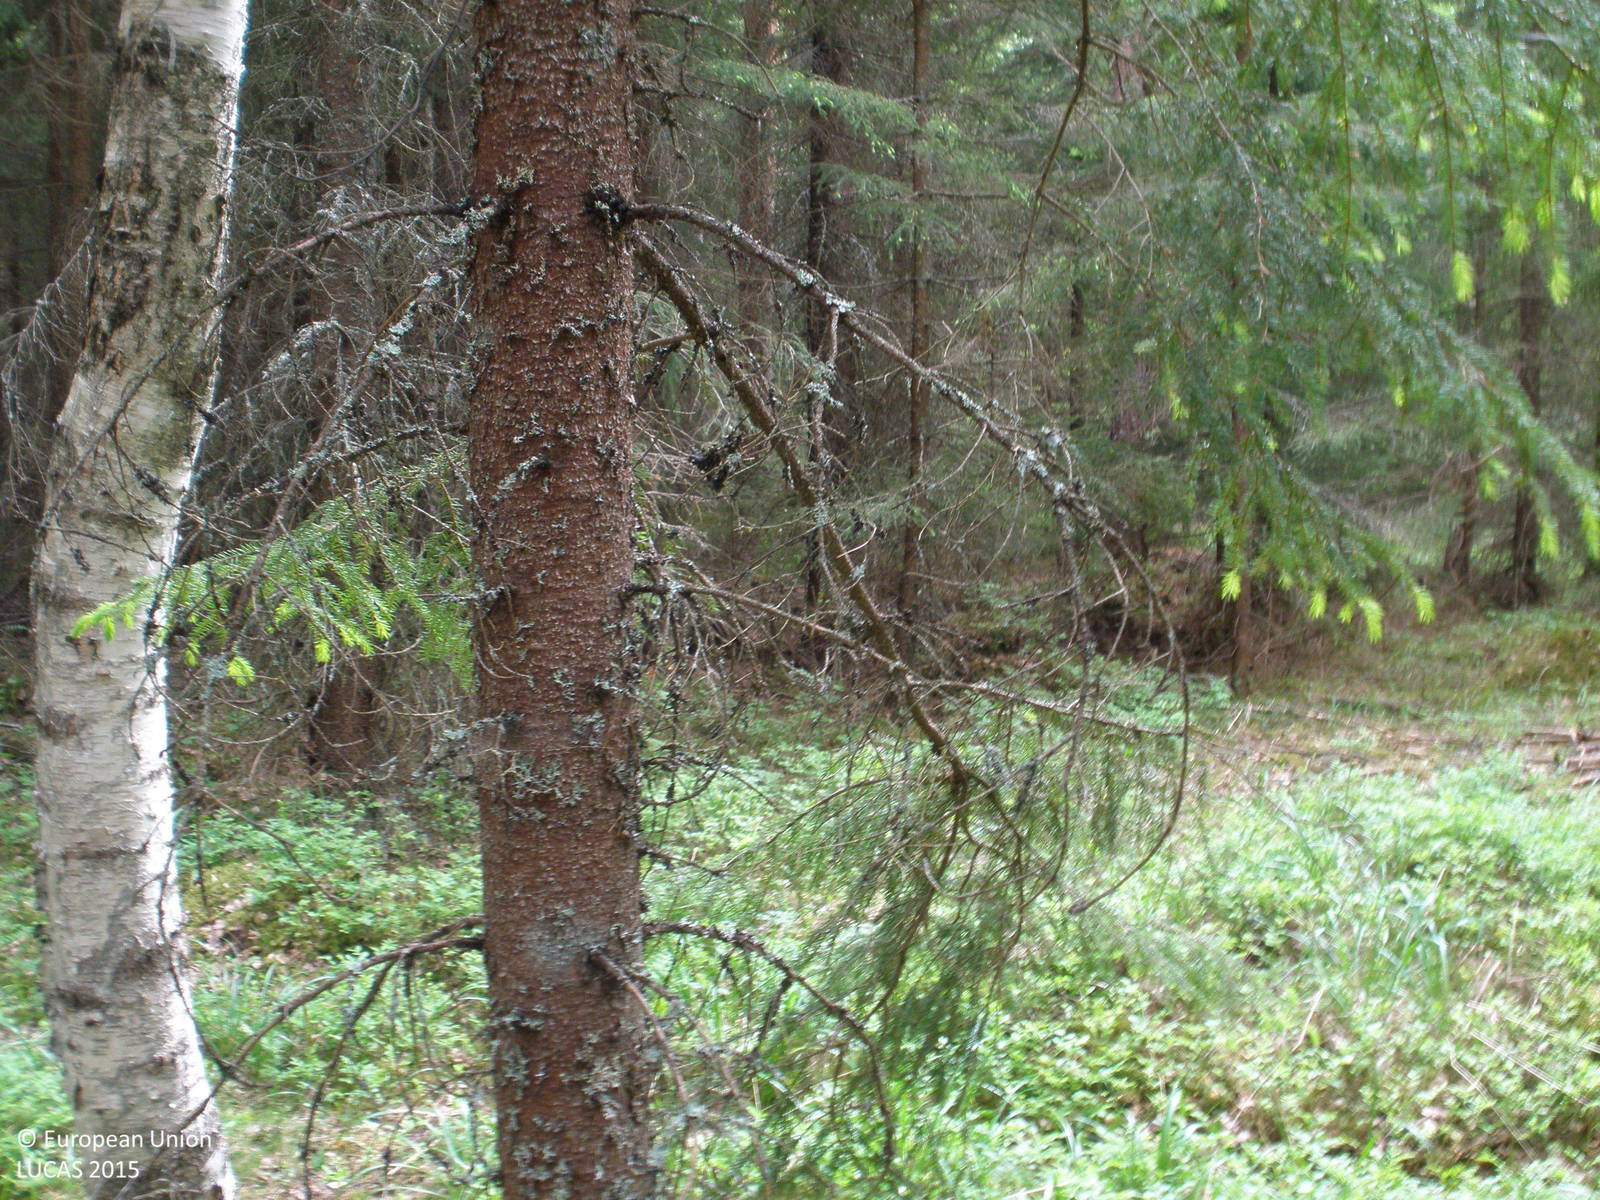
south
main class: Woodland
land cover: Pine dominated mixed woodland
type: boreal forest
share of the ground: > 75 %
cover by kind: coniferous forest trees 60 %, broadleaved forest trees 25 %, herbaceous plants 10 %, shrubs 5 %
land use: Forestry
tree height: > 5 m
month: June
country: FI
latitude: 61.0152
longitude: 24.2117
